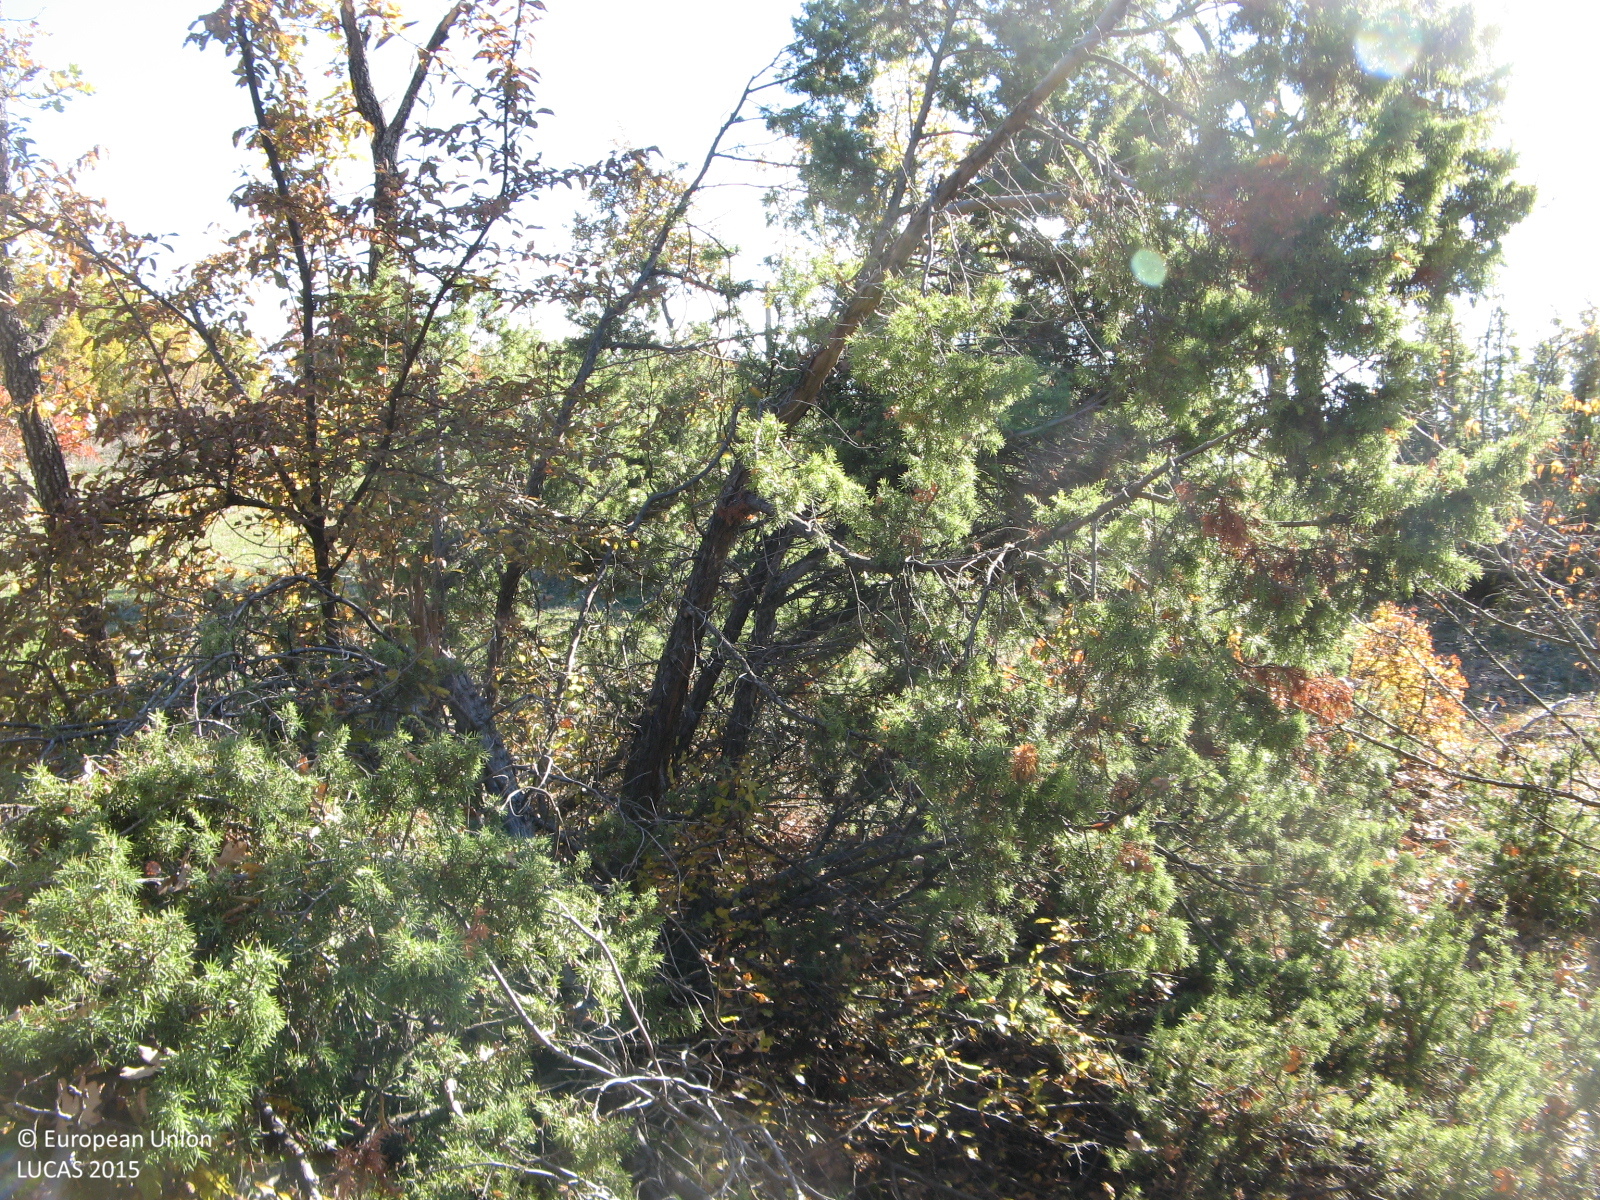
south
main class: Woodland
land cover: Broadleaved woodland
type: thermophilous deciduous forest
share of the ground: > 75 %
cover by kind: broadleaved forest trees 95 %, herbaceous plants 5 %
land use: Forestry
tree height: > 5 m
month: November
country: BG
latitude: 41.5403
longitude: 25.2893
